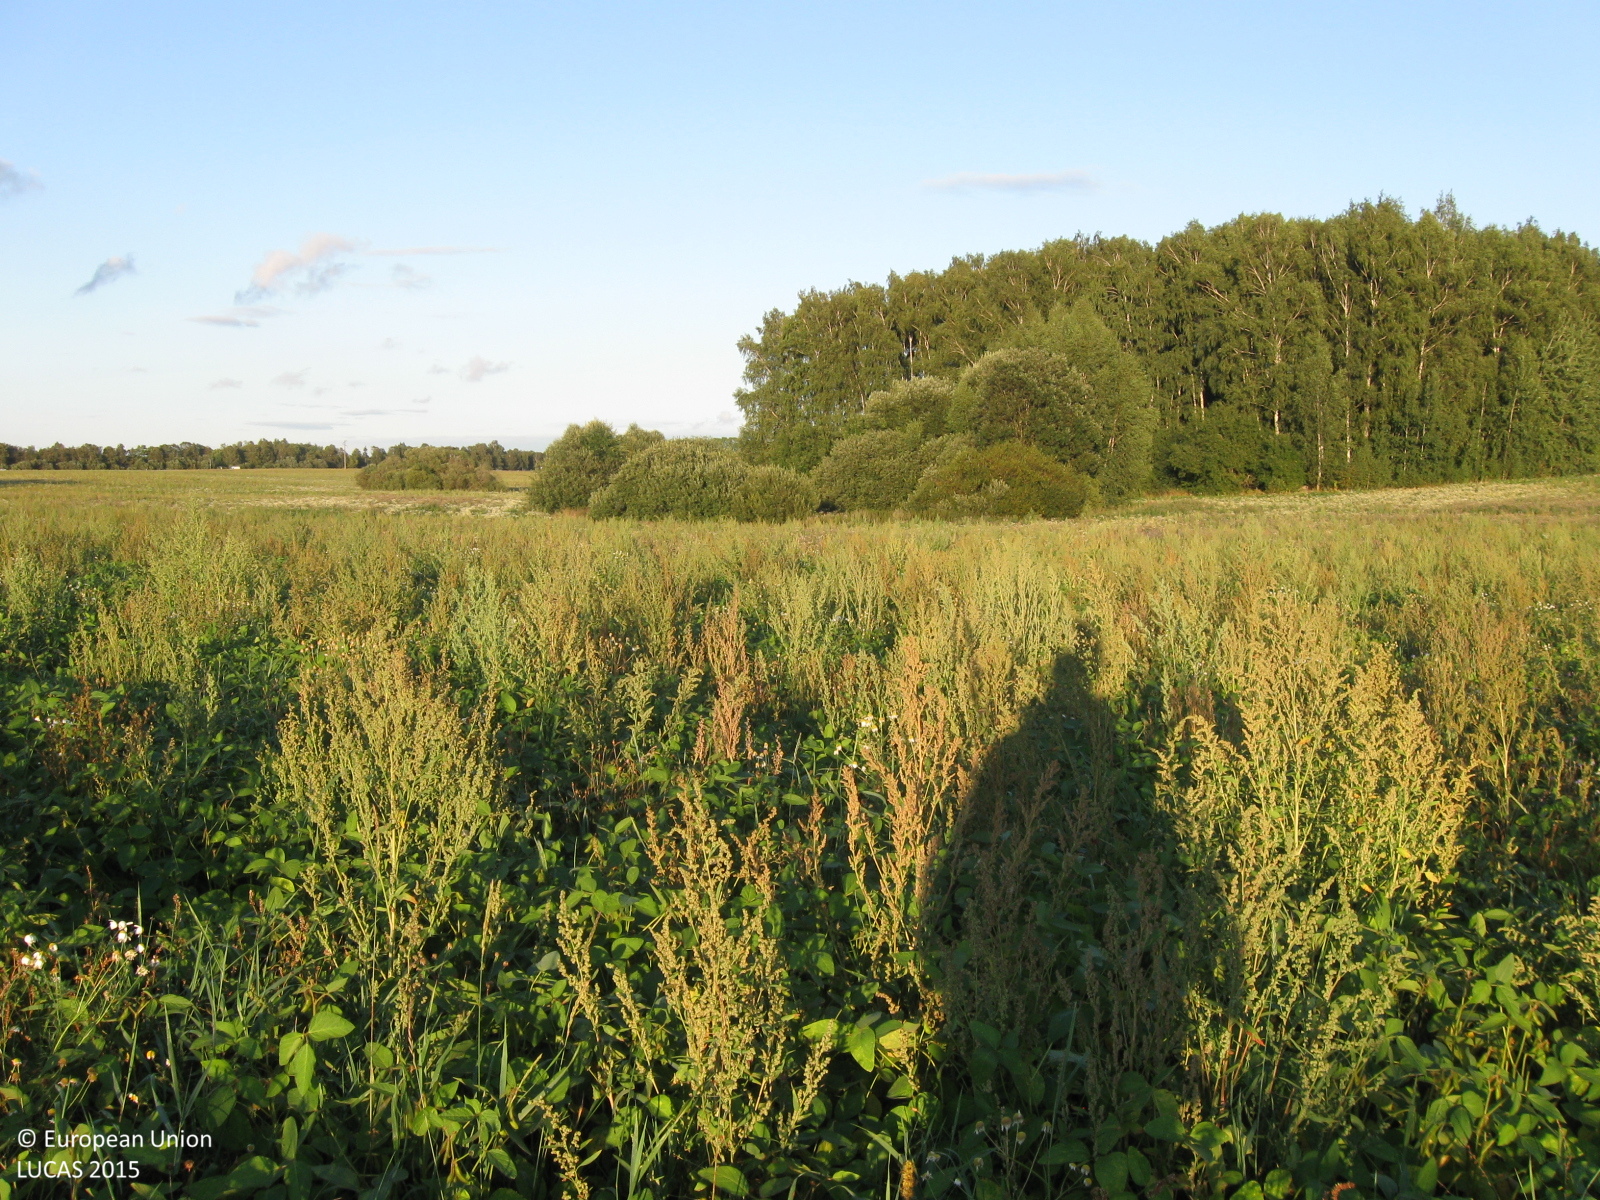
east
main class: Cropland
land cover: Soya
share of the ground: > 75 %
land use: Agriculture (excluding fallow land and kitchen gardens)
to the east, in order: Soya; Spontaneously vegetated surfaces; Broadleaved woodland; Spontaneously vegetated surfaces; Broadleaved woodland; Soya; Broadleaved woodland; Soya
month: August
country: LT
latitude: 55.2952
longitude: 23.2569
